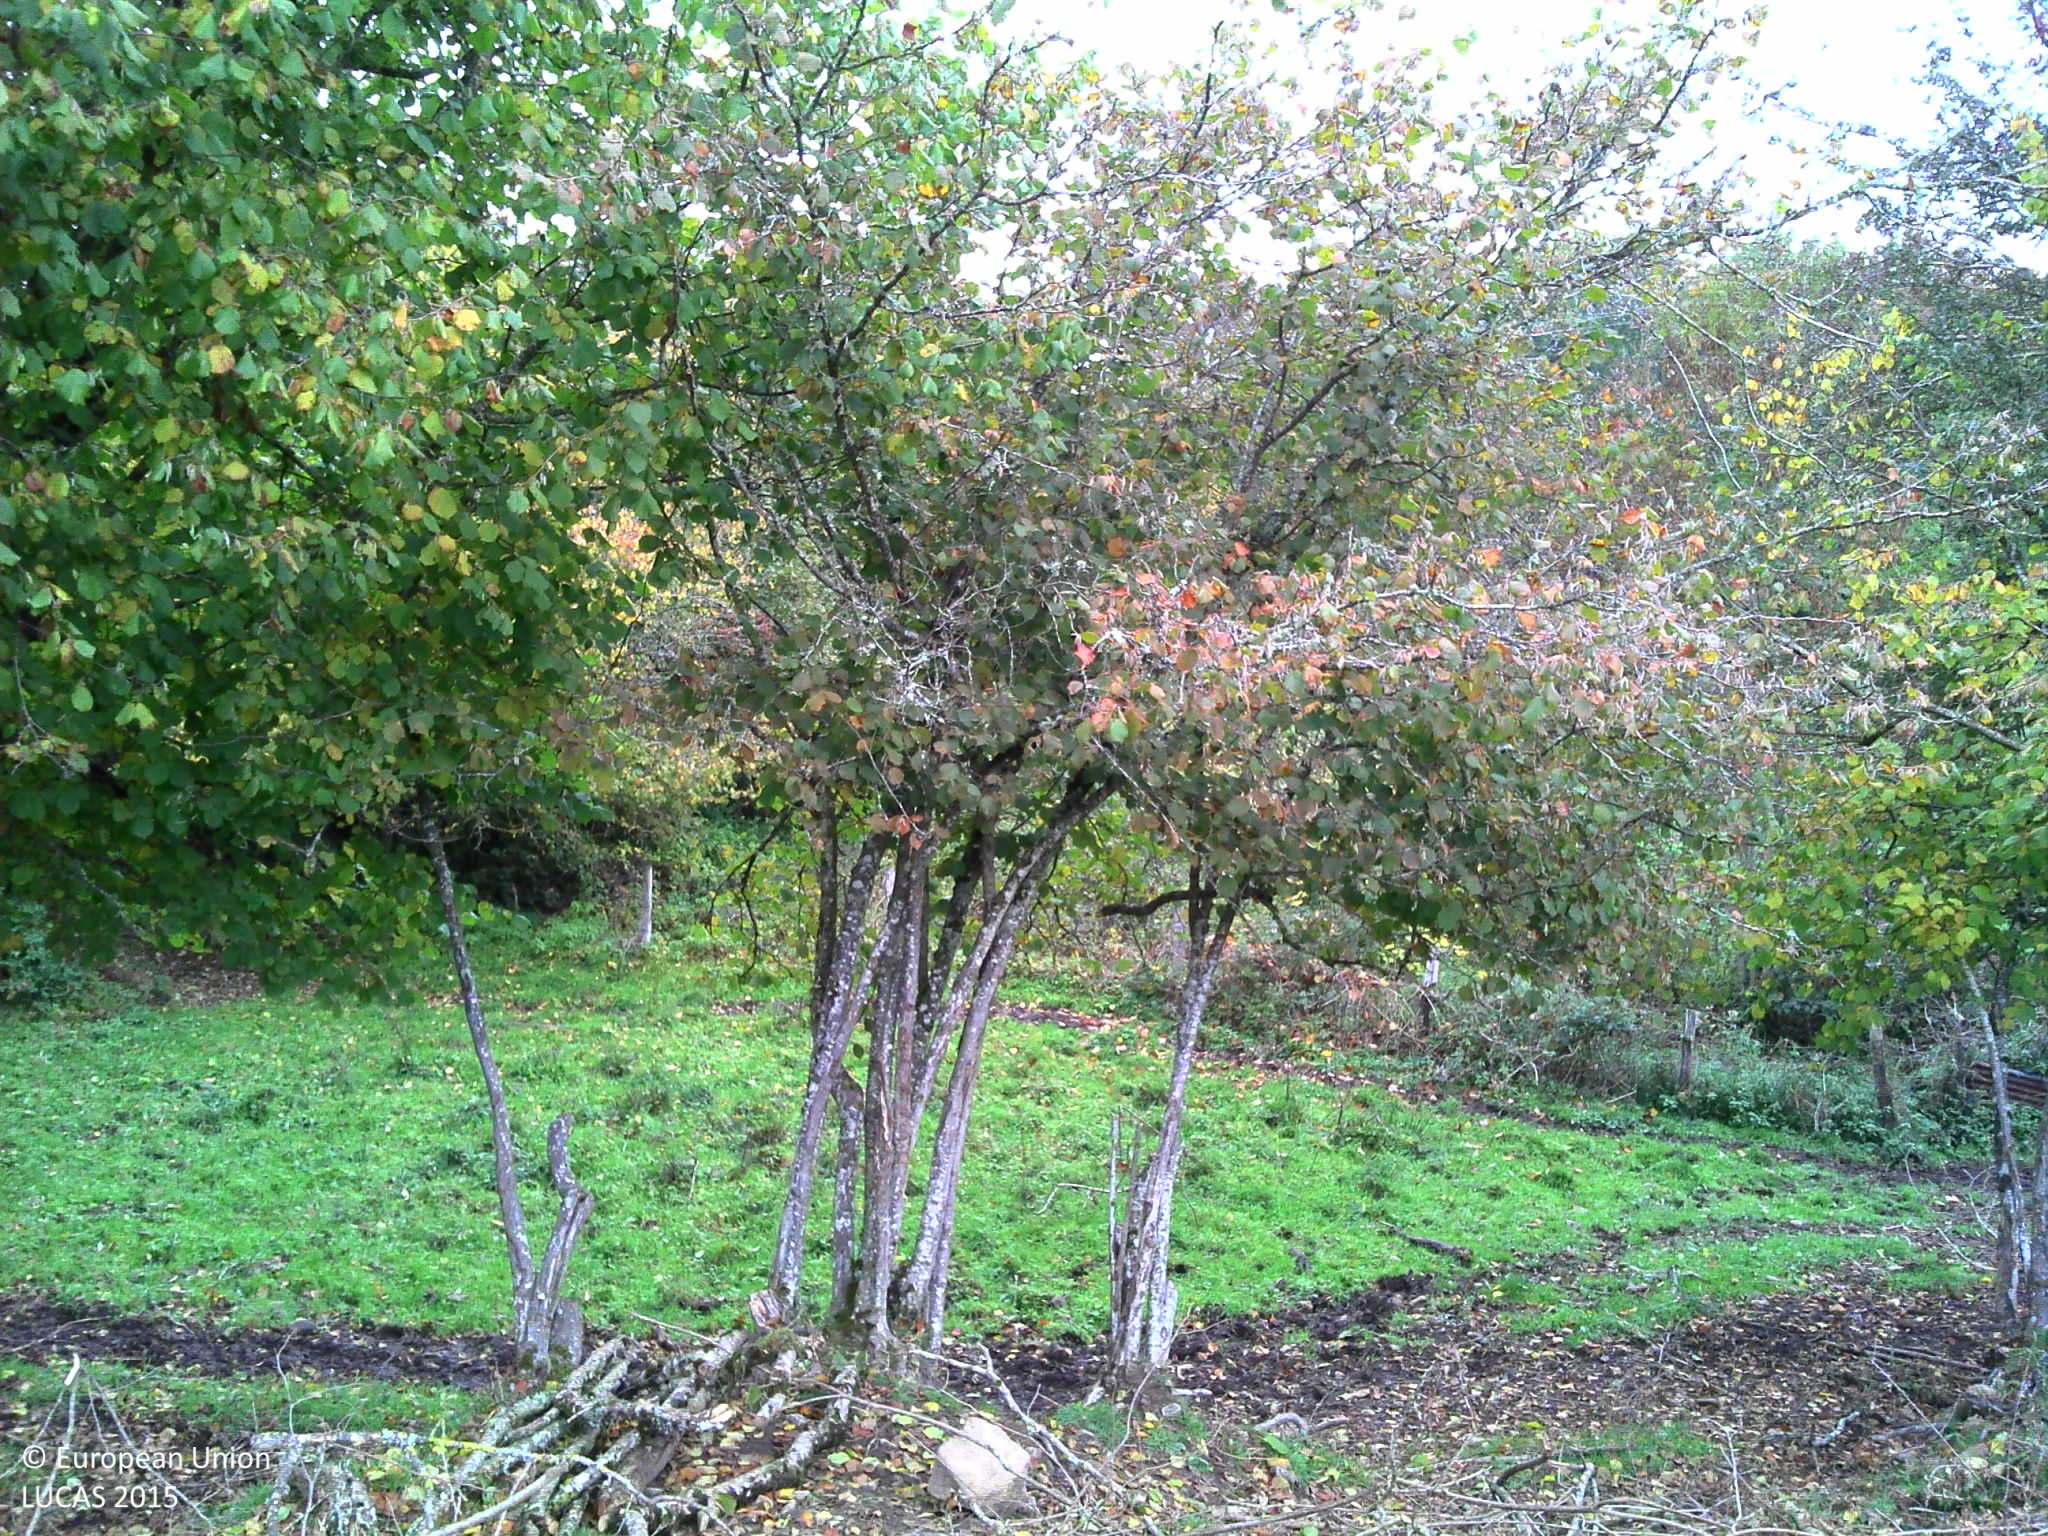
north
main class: Grassland
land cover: Grassland without tree/shrub cover
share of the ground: > 75 %
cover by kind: herbaceous plants 90 %, unconsolidated bare surface 10 %
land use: Agriculture (excluding fallow land and kitchen gardens)
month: October
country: FR
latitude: 46.0217
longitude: 2.8547
